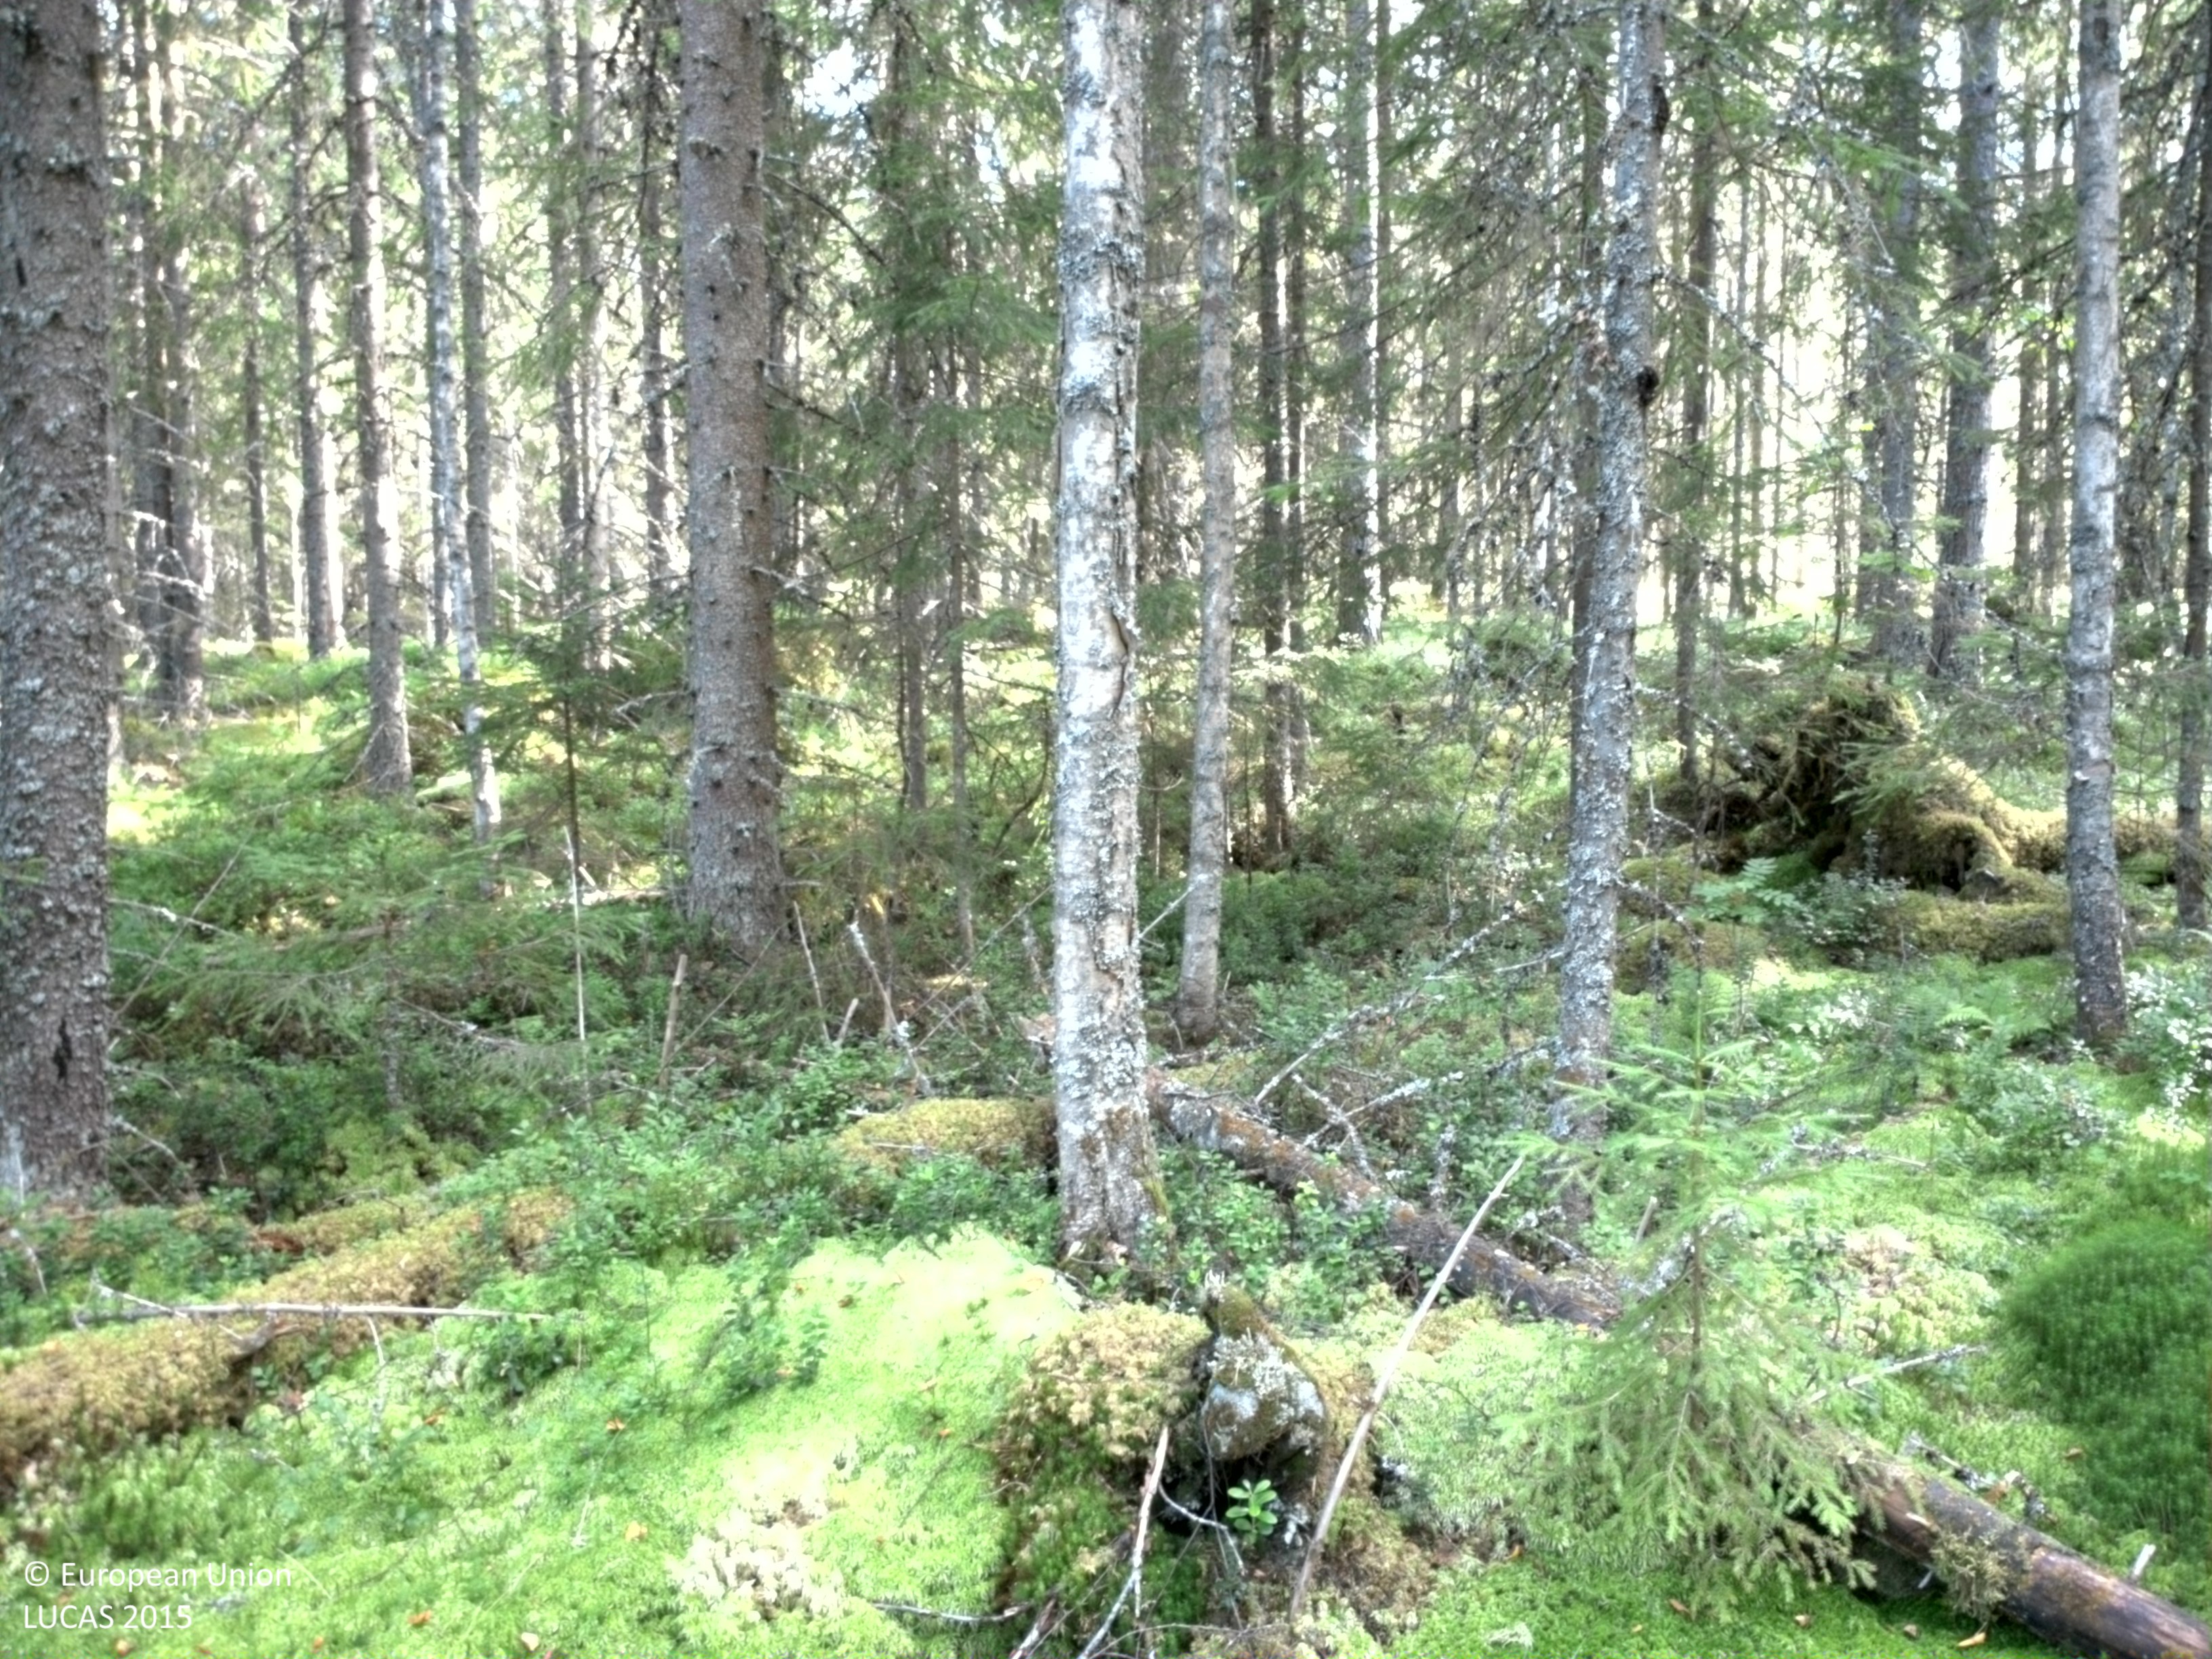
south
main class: Woodland
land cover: Spruce dominated coniferous woodland
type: boreal forest
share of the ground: 50 - 75 %
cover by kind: coniferous forest trees 65 %, shrubs 15 %, lichens and mosses 10 %, broadleaved forest trees 5 %, herbaceous plants 5 %
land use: Forestry
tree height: > 5 m
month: August
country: SE
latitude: 60.2801
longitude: 13.5525
